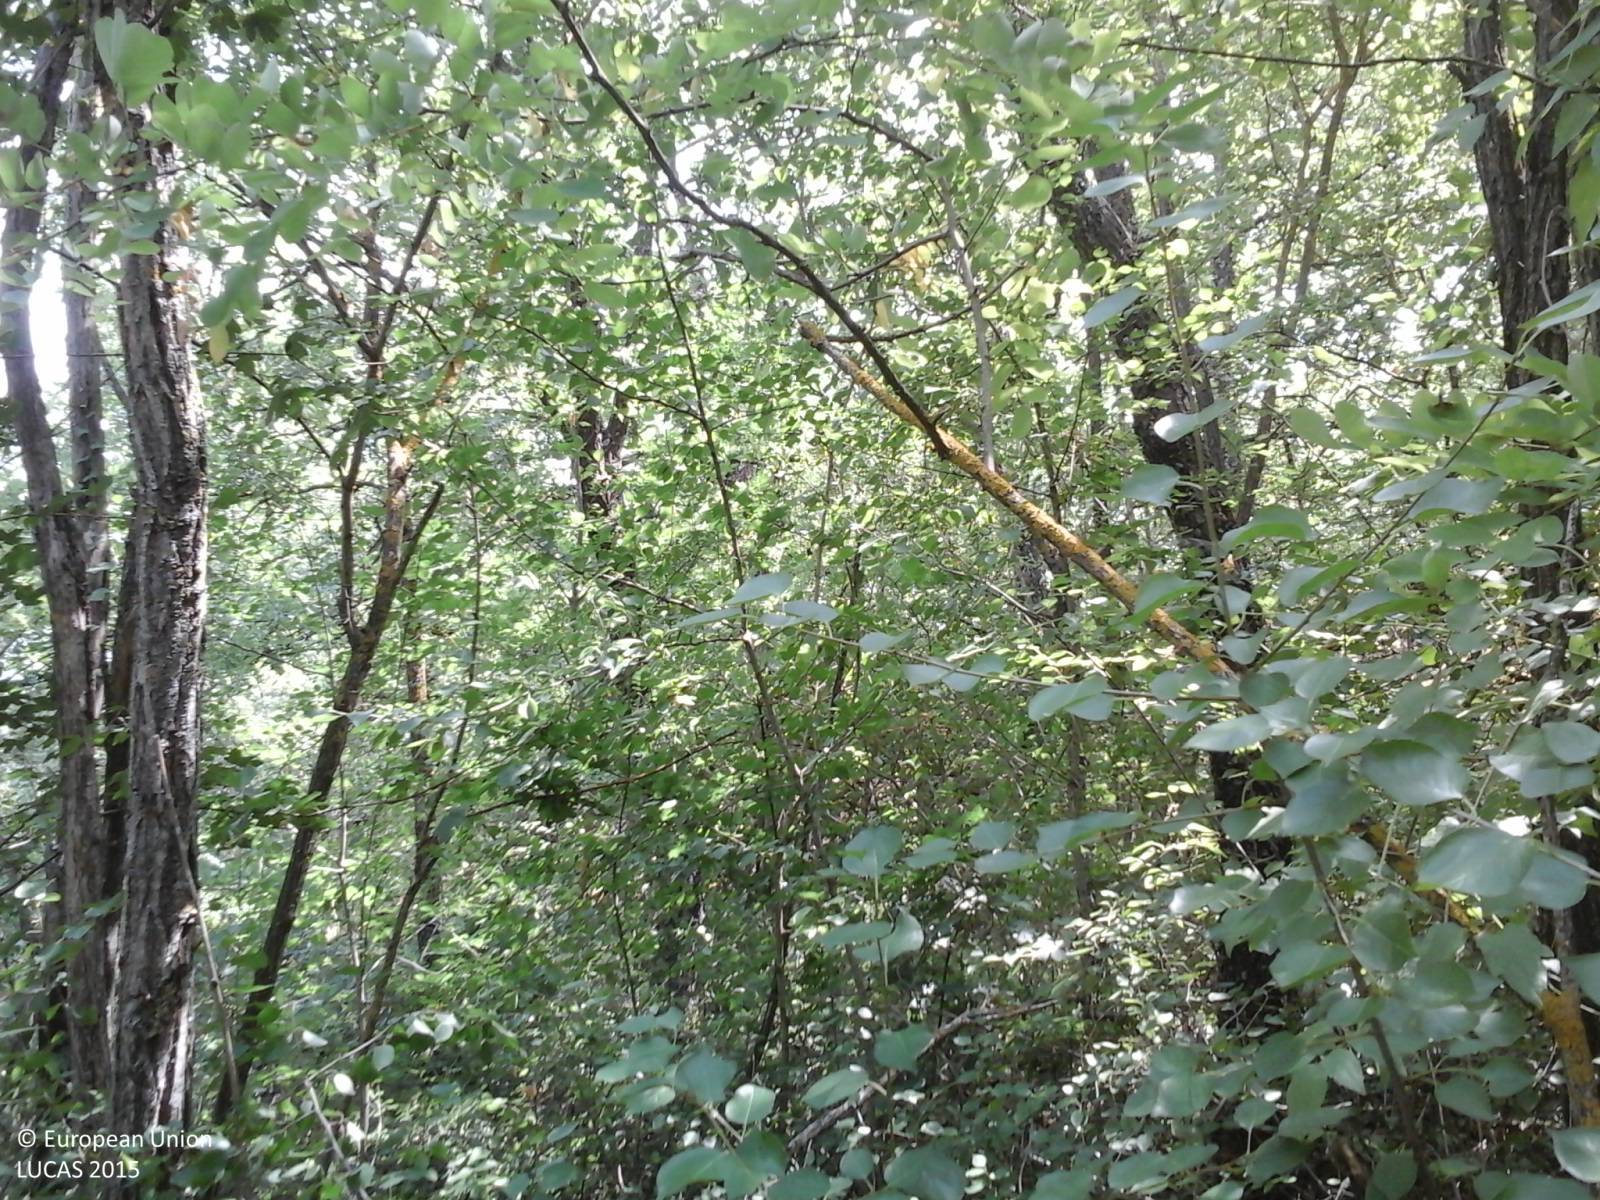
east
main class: Woodland
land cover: Broadleaved woodland
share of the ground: > 75 %
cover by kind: broadleaved forest trees 100 %
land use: Semi-natural and natural areas not in use
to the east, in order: Broadleaved woodland; Electric lines; Broadleaved woodland; Artificial constructions in urban areas
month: July
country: IT
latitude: 42.3258
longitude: 13.3989
